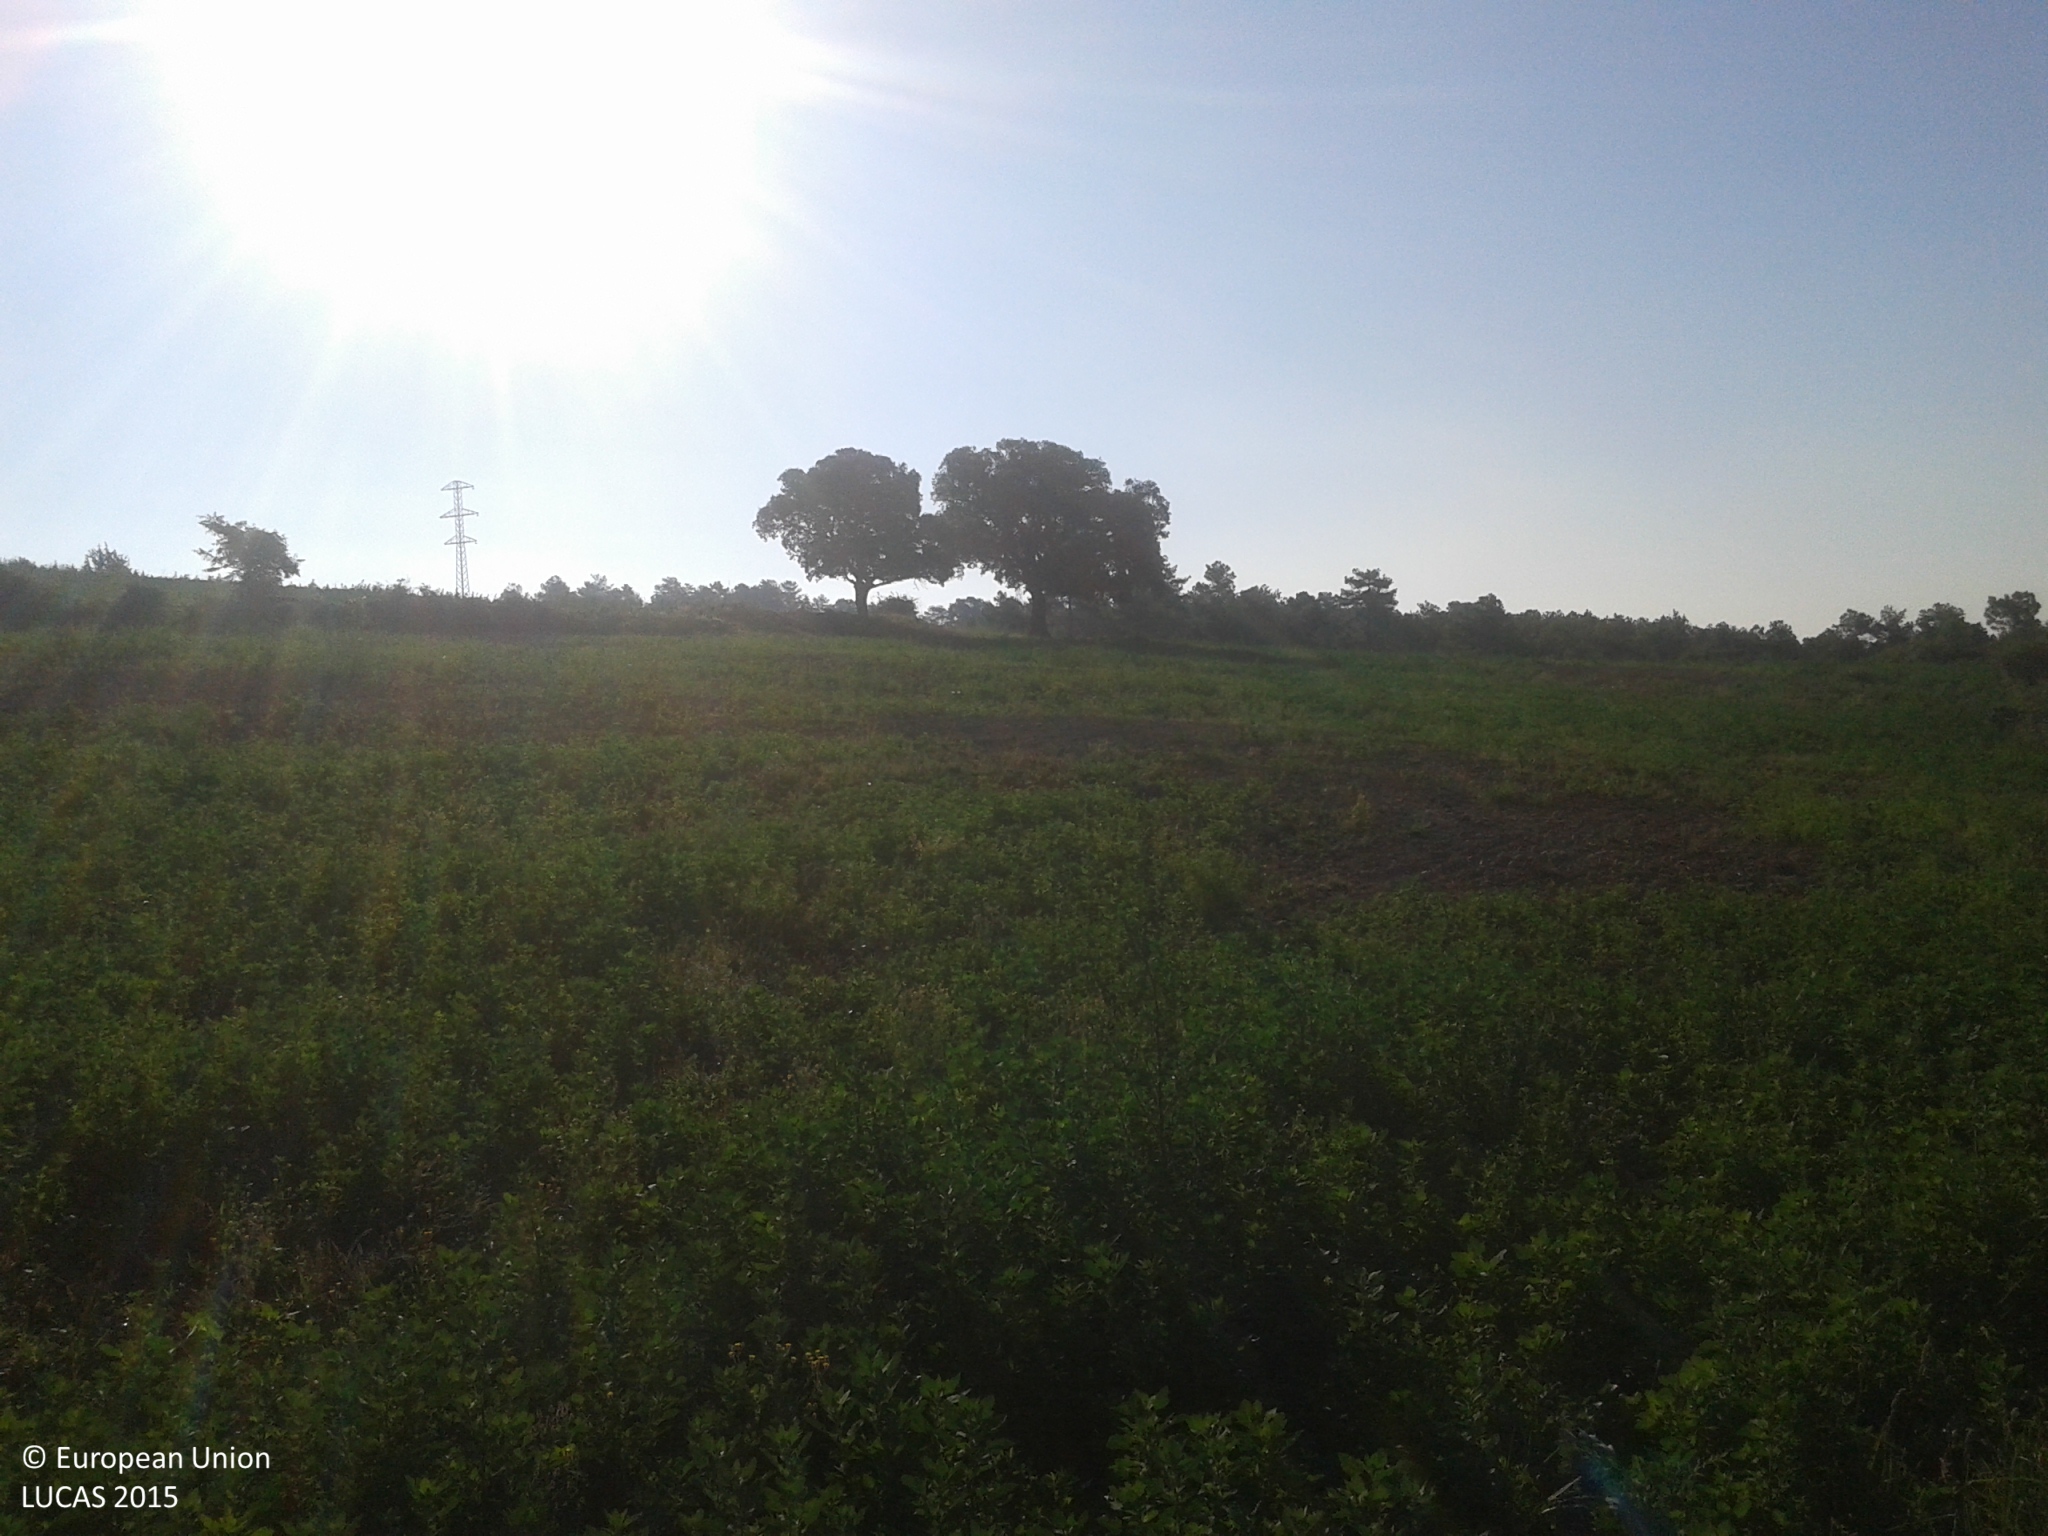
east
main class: Cropland
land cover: Temporary grasslands
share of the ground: > 75 %
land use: Agriculture (excluding fallow land and kitchen gardens)
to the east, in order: Shruby margins; Temporary grasslands; Single bushes/trees; Temporary grasslands; Pine dominated coniferous woodland; Temporary grasslands
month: June
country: ES
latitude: 42.0278
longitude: 1.5457
